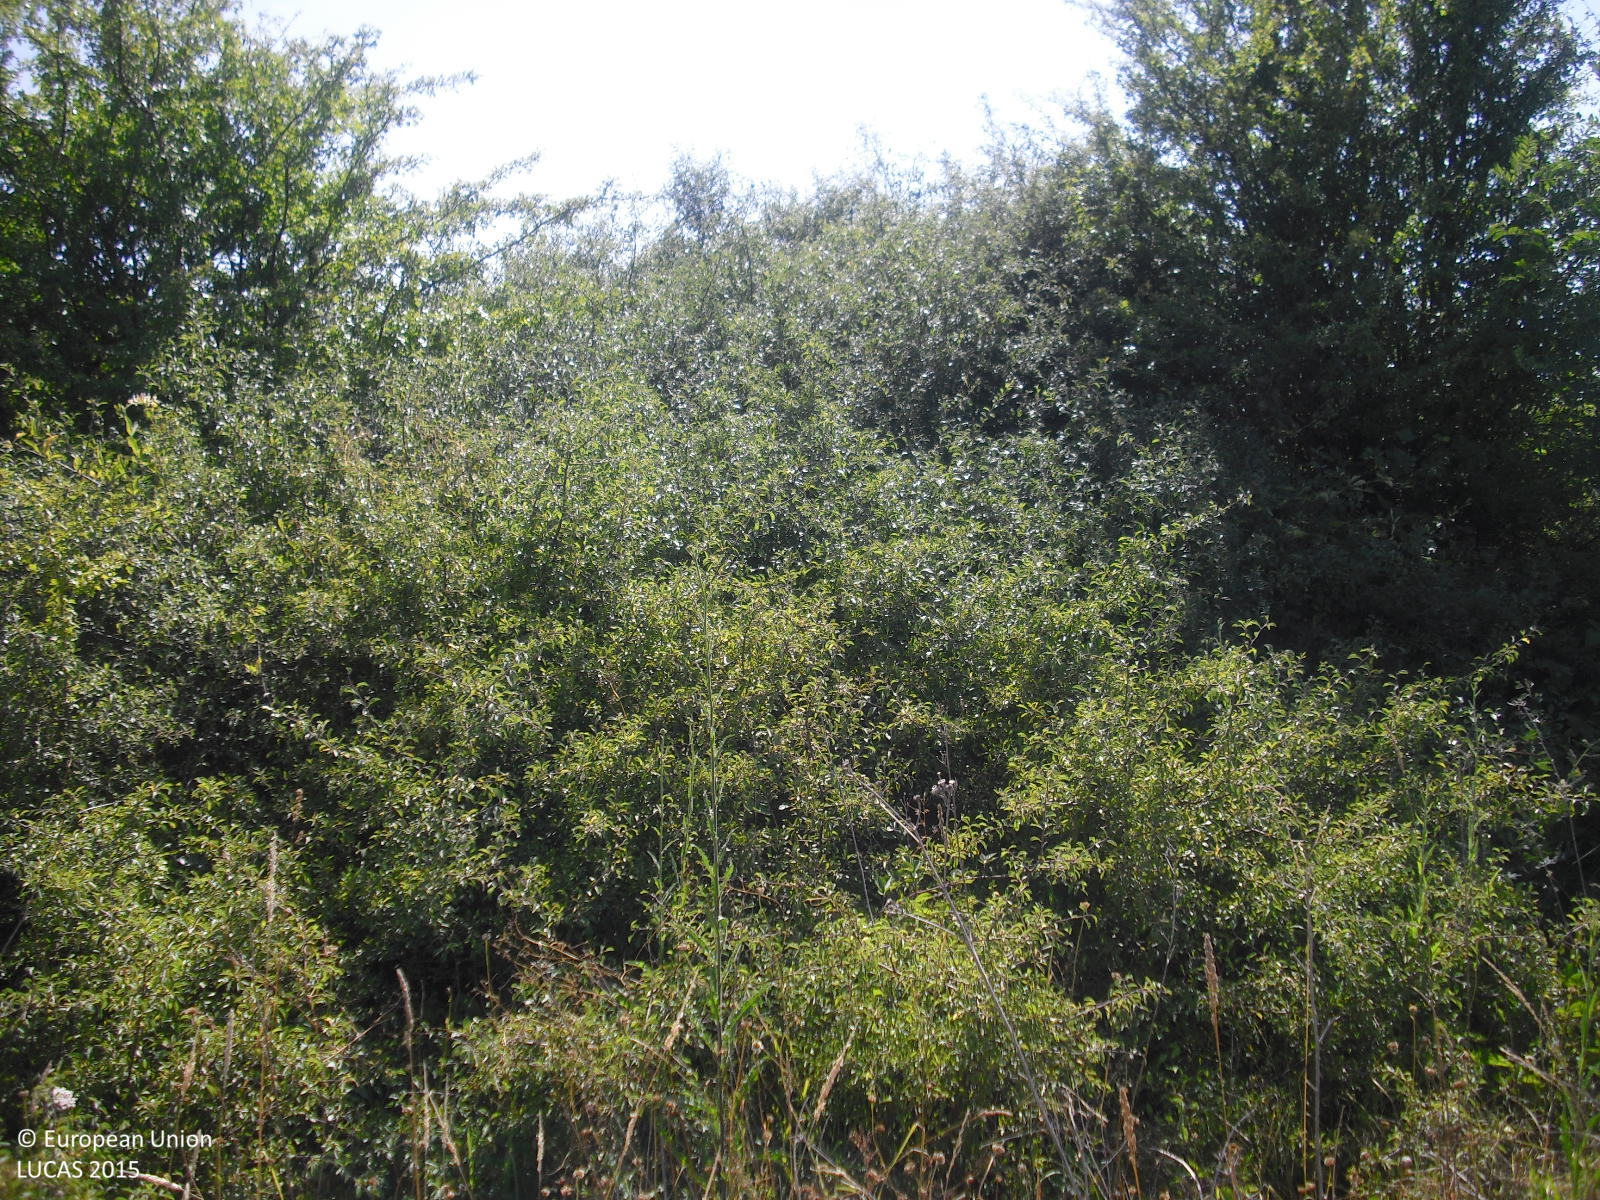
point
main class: Shrubland
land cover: Shrubland with sparse tree cover
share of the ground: 50 - 75 %
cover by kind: shrubs 60 %, herbaceous plants 35 %, broadleaved forest trees 5 %
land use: Abandoned areas
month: July
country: ES
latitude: 42.5547
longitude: -7.4981
